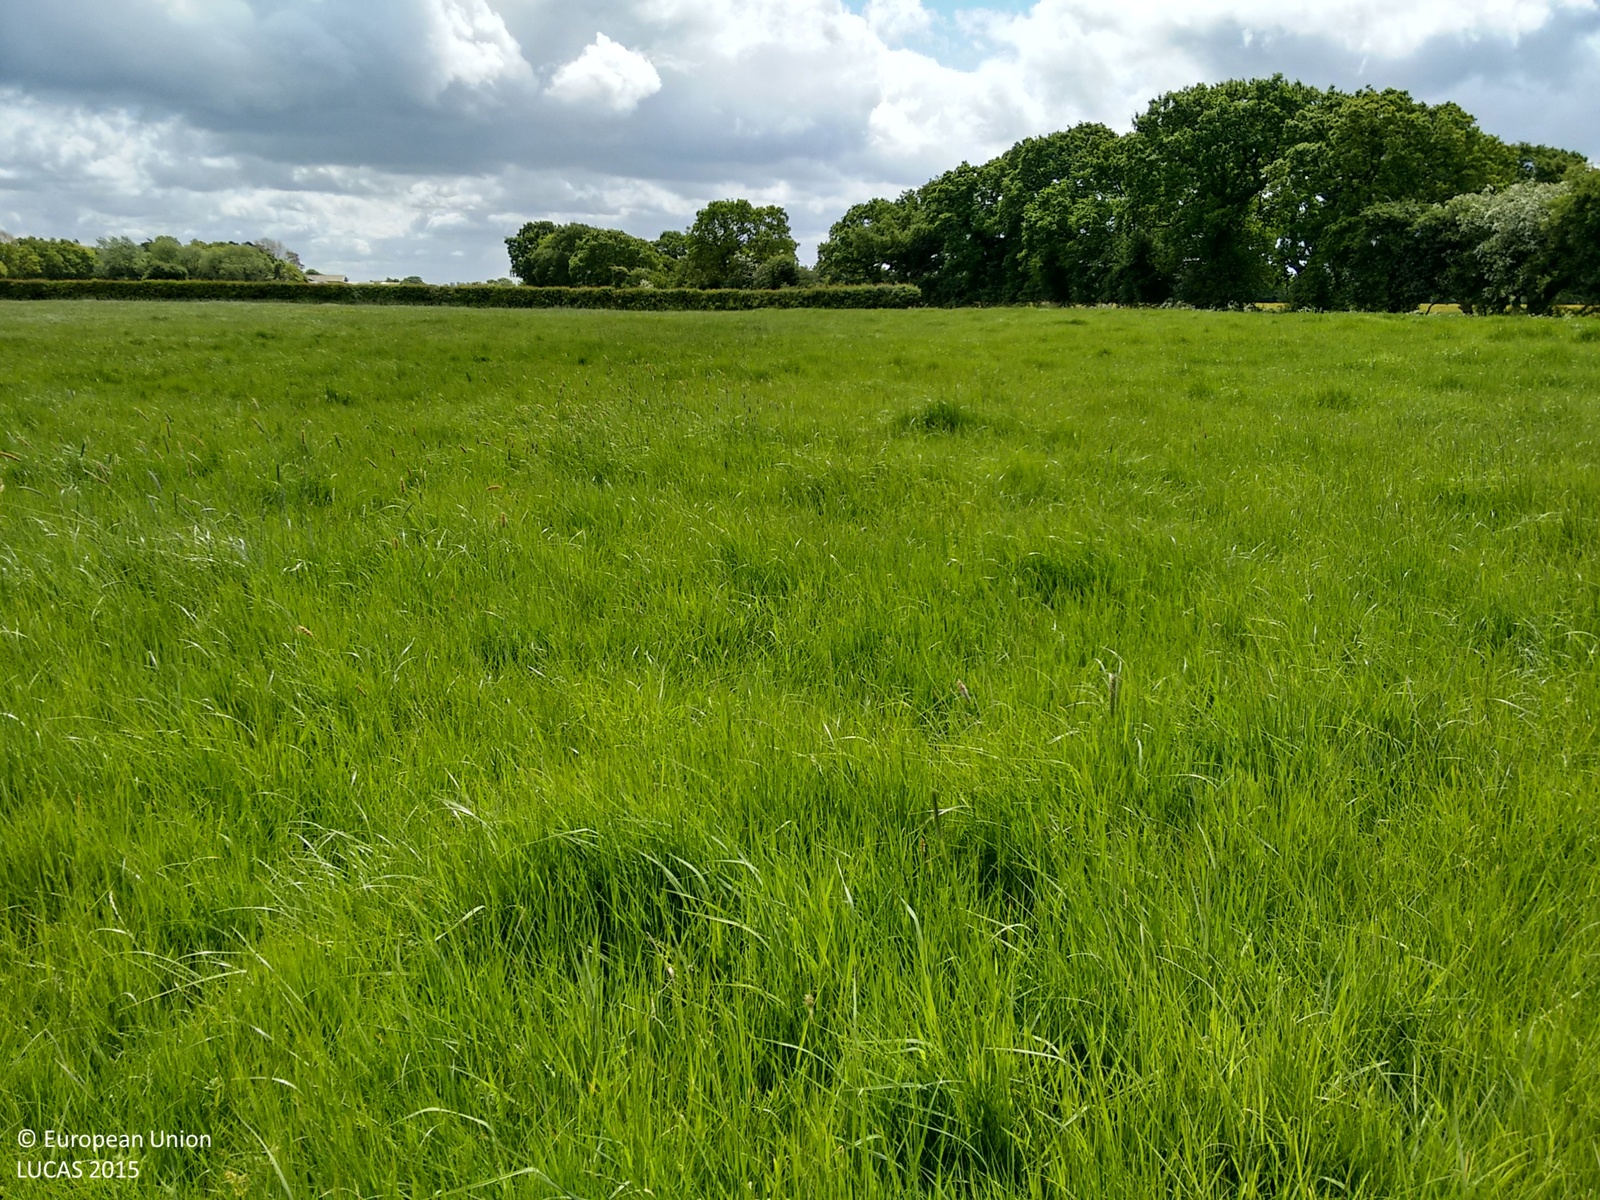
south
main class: Grassland
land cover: Grassland without tree/shrub cover
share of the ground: > 75 %
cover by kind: herbaceous plants 100 %
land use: Agriculture (excluding fallow land and kitchen gardens)
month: May
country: GB
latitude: 53.9683
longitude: -1.2195
